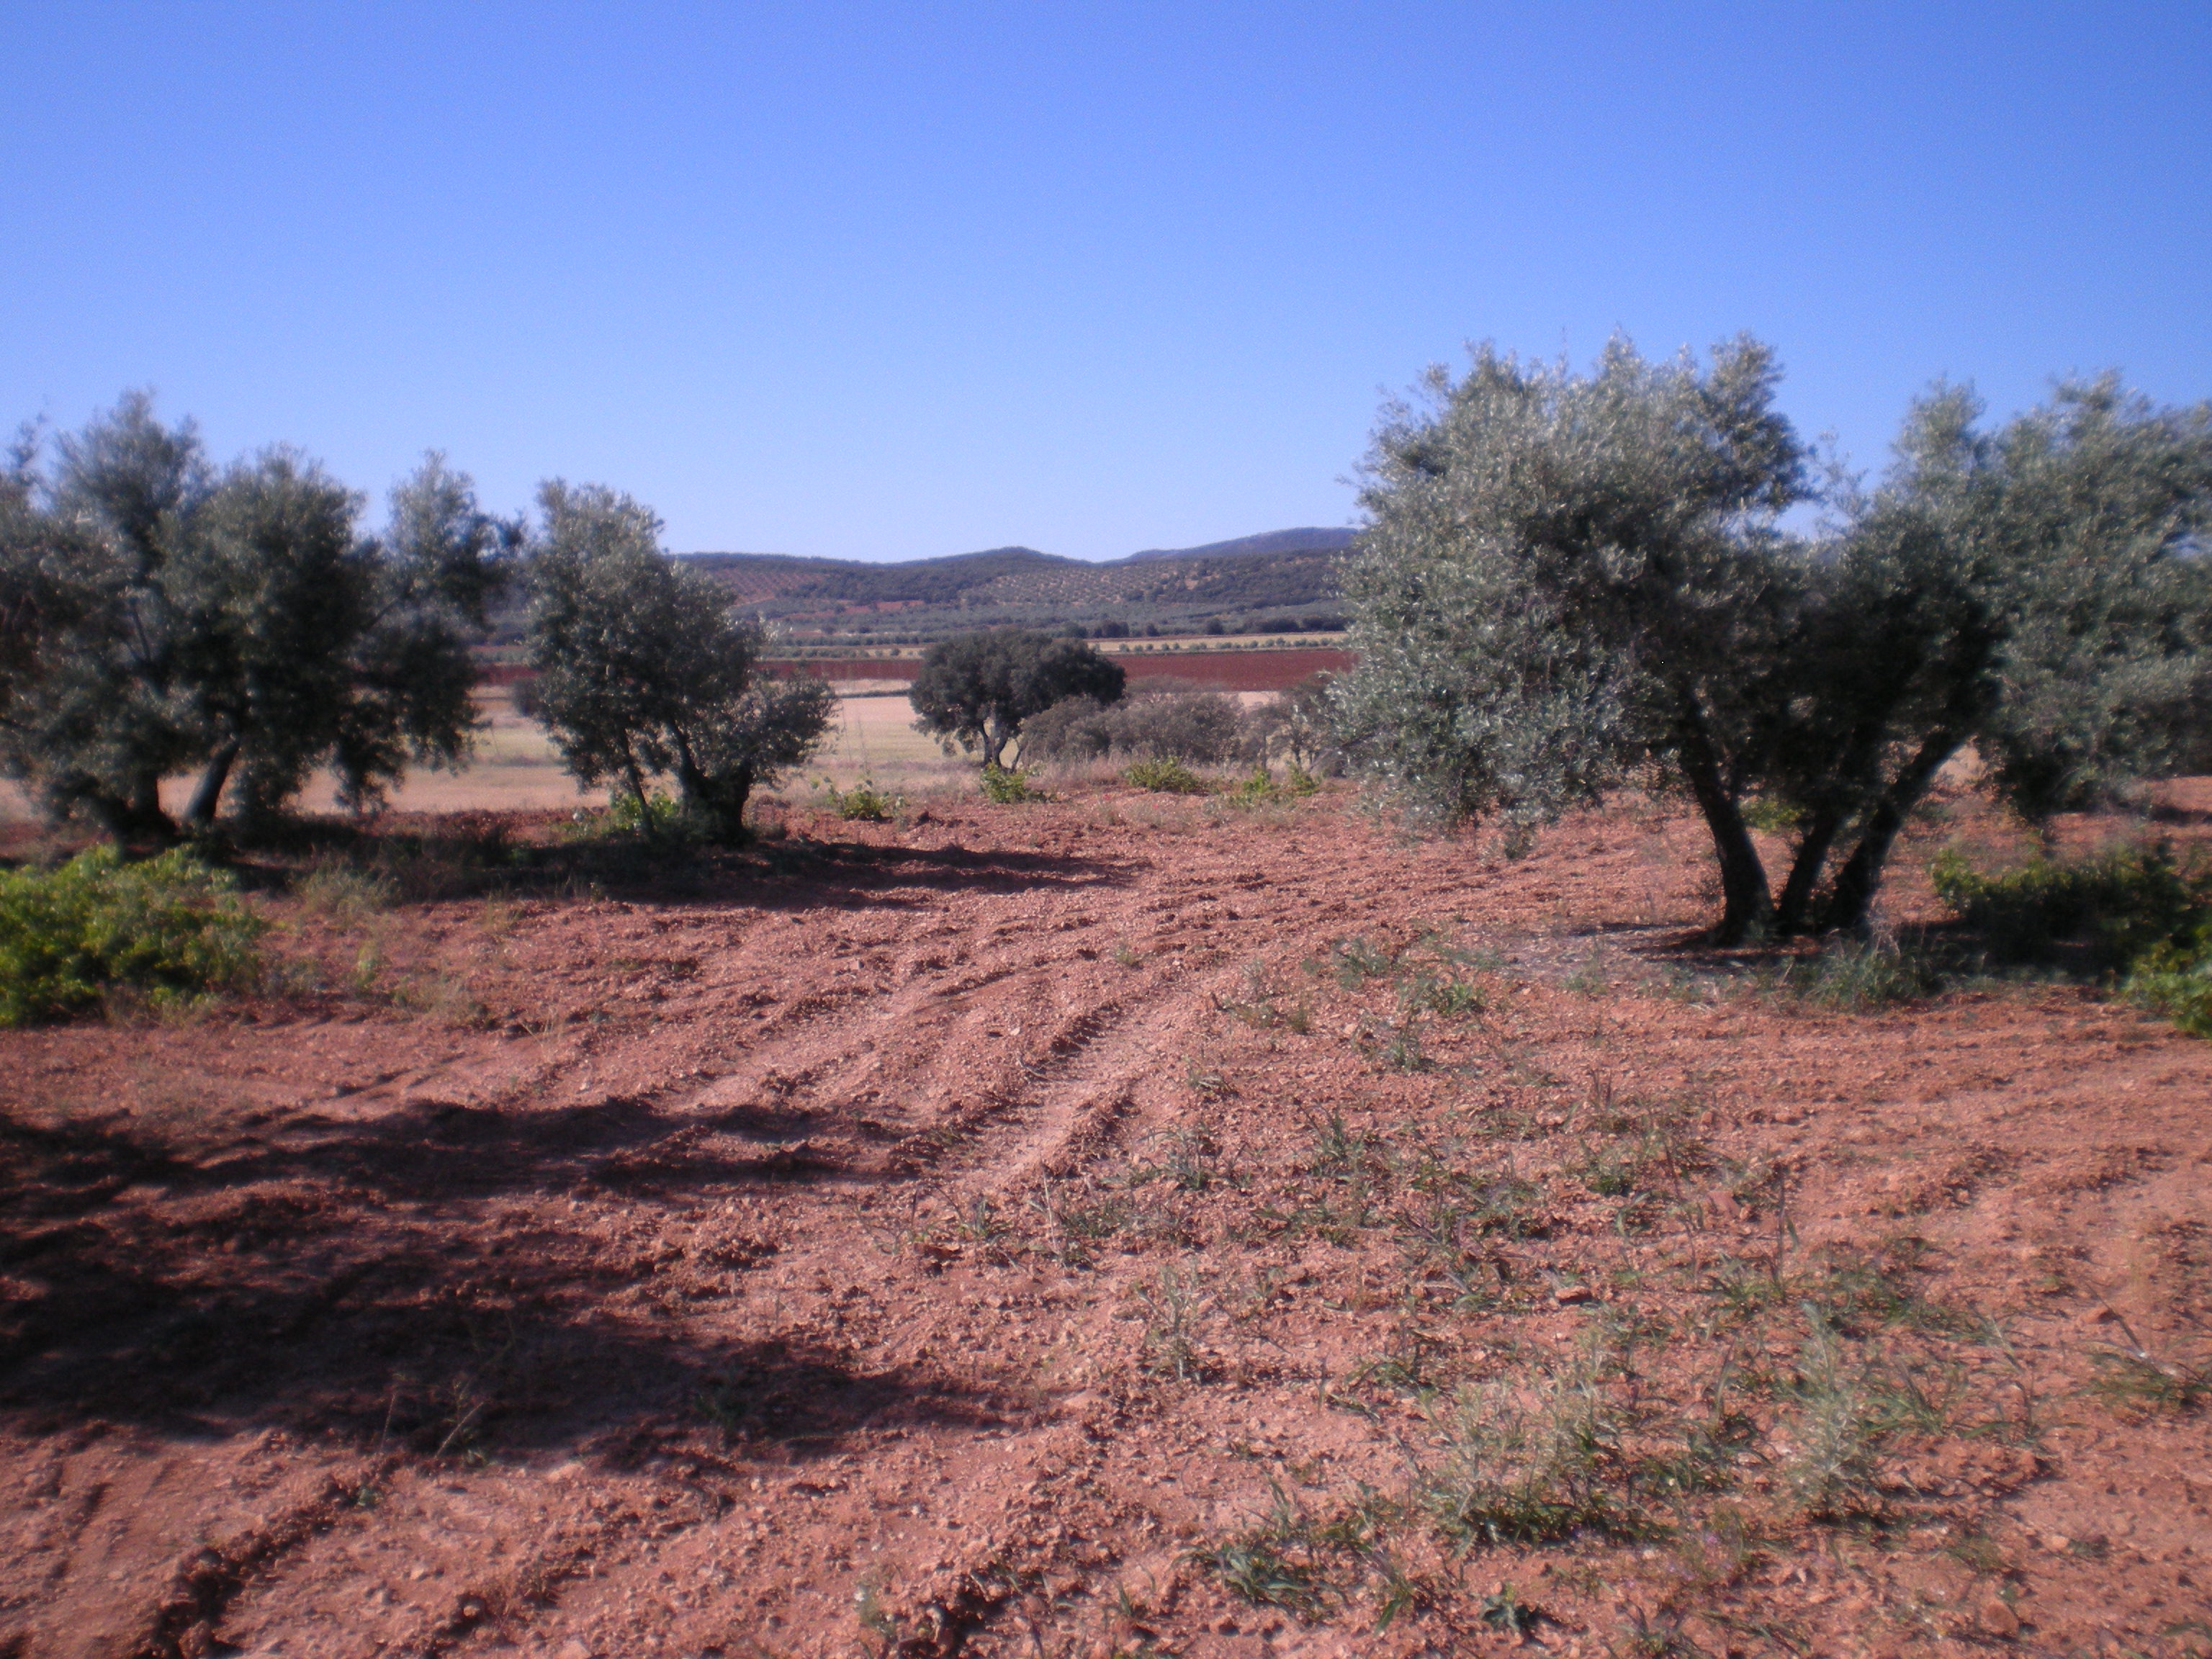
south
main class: Cropland
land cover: Olive groves
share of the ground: 10 - 25 %
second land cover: Spontaneously vegetated surfaces
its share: 10 - 25 %
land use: Agriculture (excluding fallow land and kitchen gardens)
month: May
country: ES
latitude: 38.5295
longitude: -3.3250
